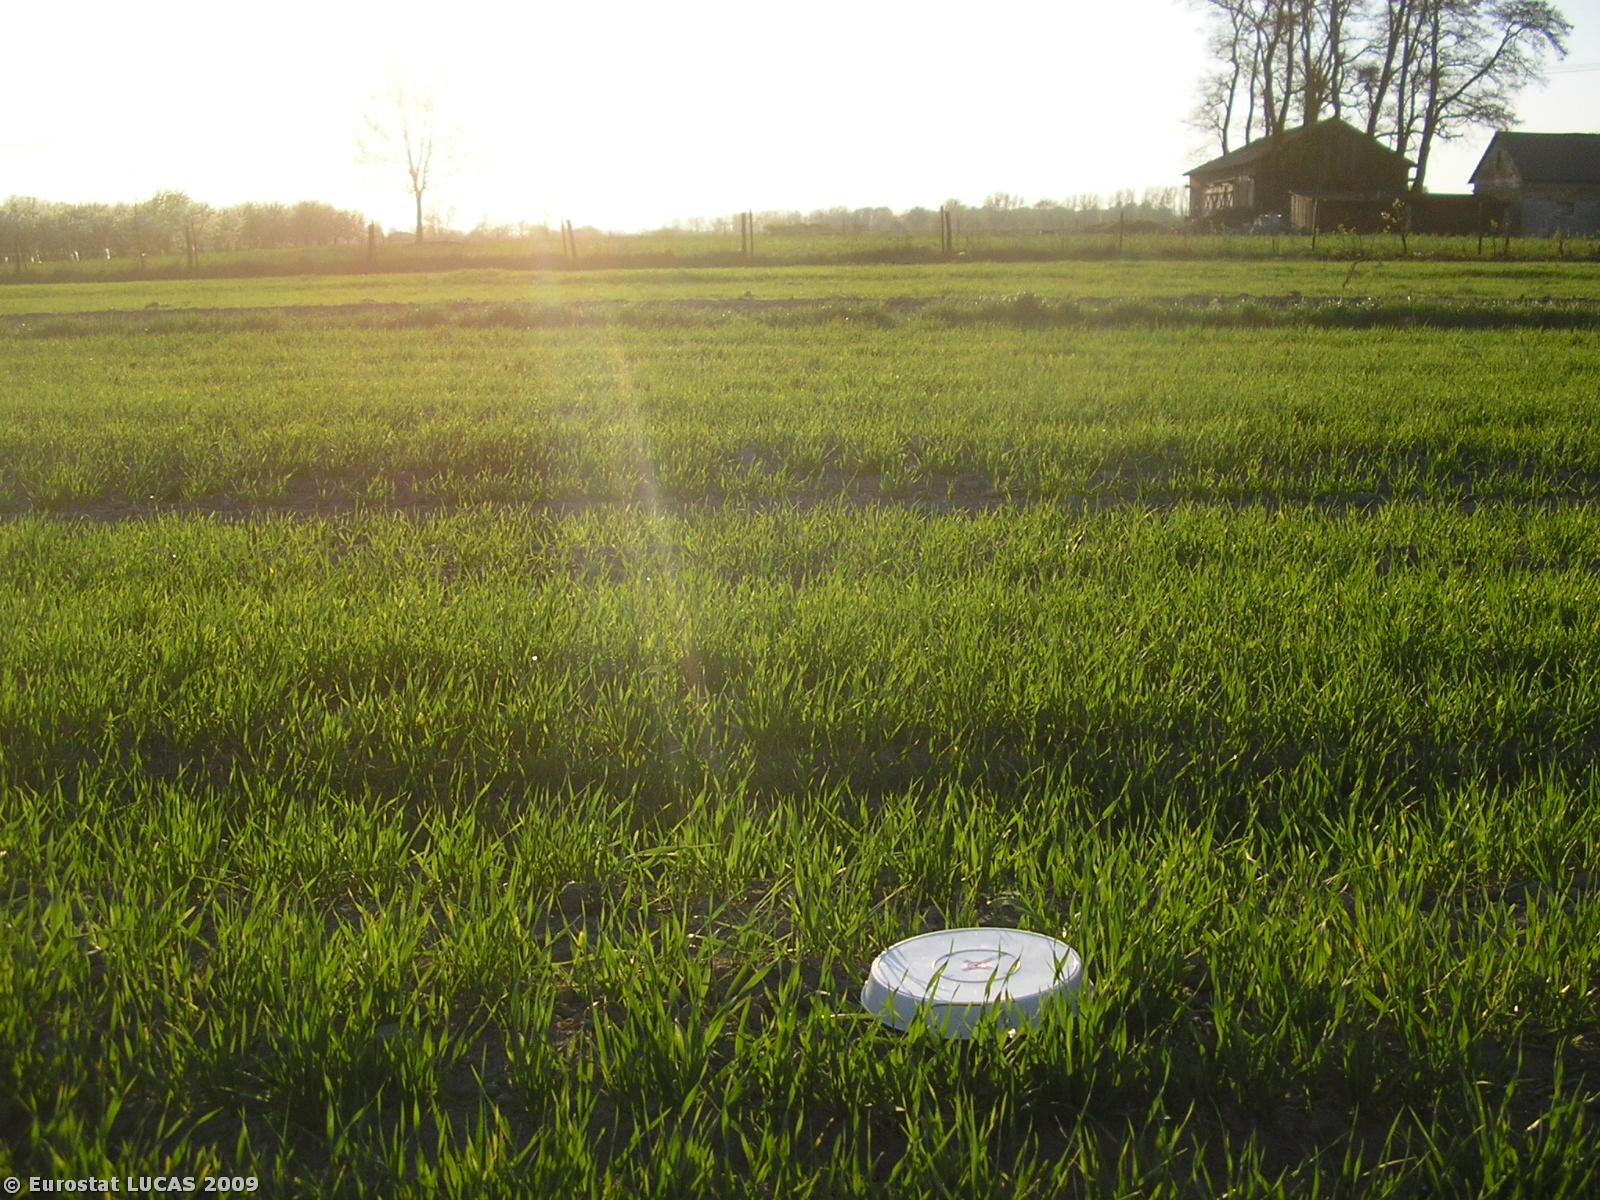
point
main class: Cropland
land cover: Mixed cereals for fodder
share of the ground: 25 - 50 %
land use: Agriculture (excluding fallow land and kitchen gardens)
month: April
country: PL
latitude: 52.2336
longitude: 20.1225
